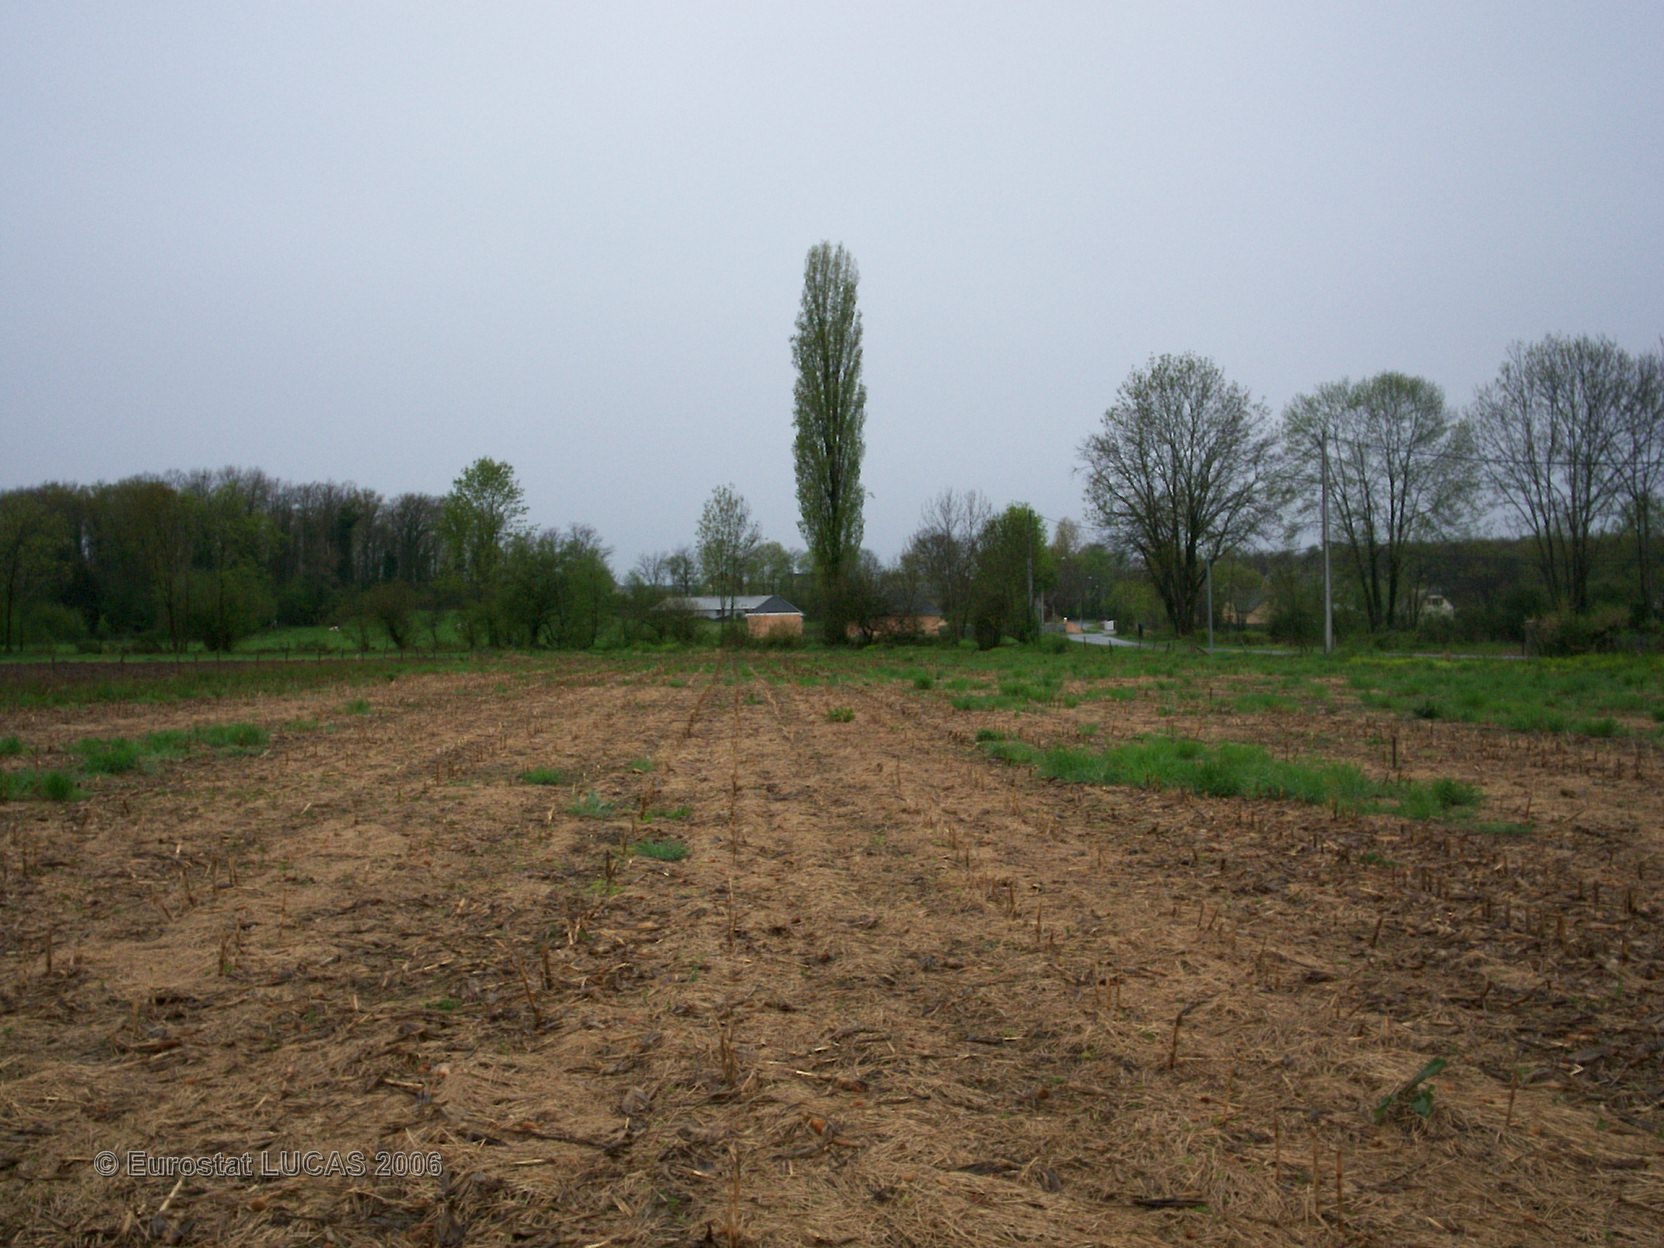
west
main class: Grassland
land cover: Grassland without tree/shrub cover
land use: Fallow land
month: June
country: FR
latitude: 43.2171
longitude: -0.1357
